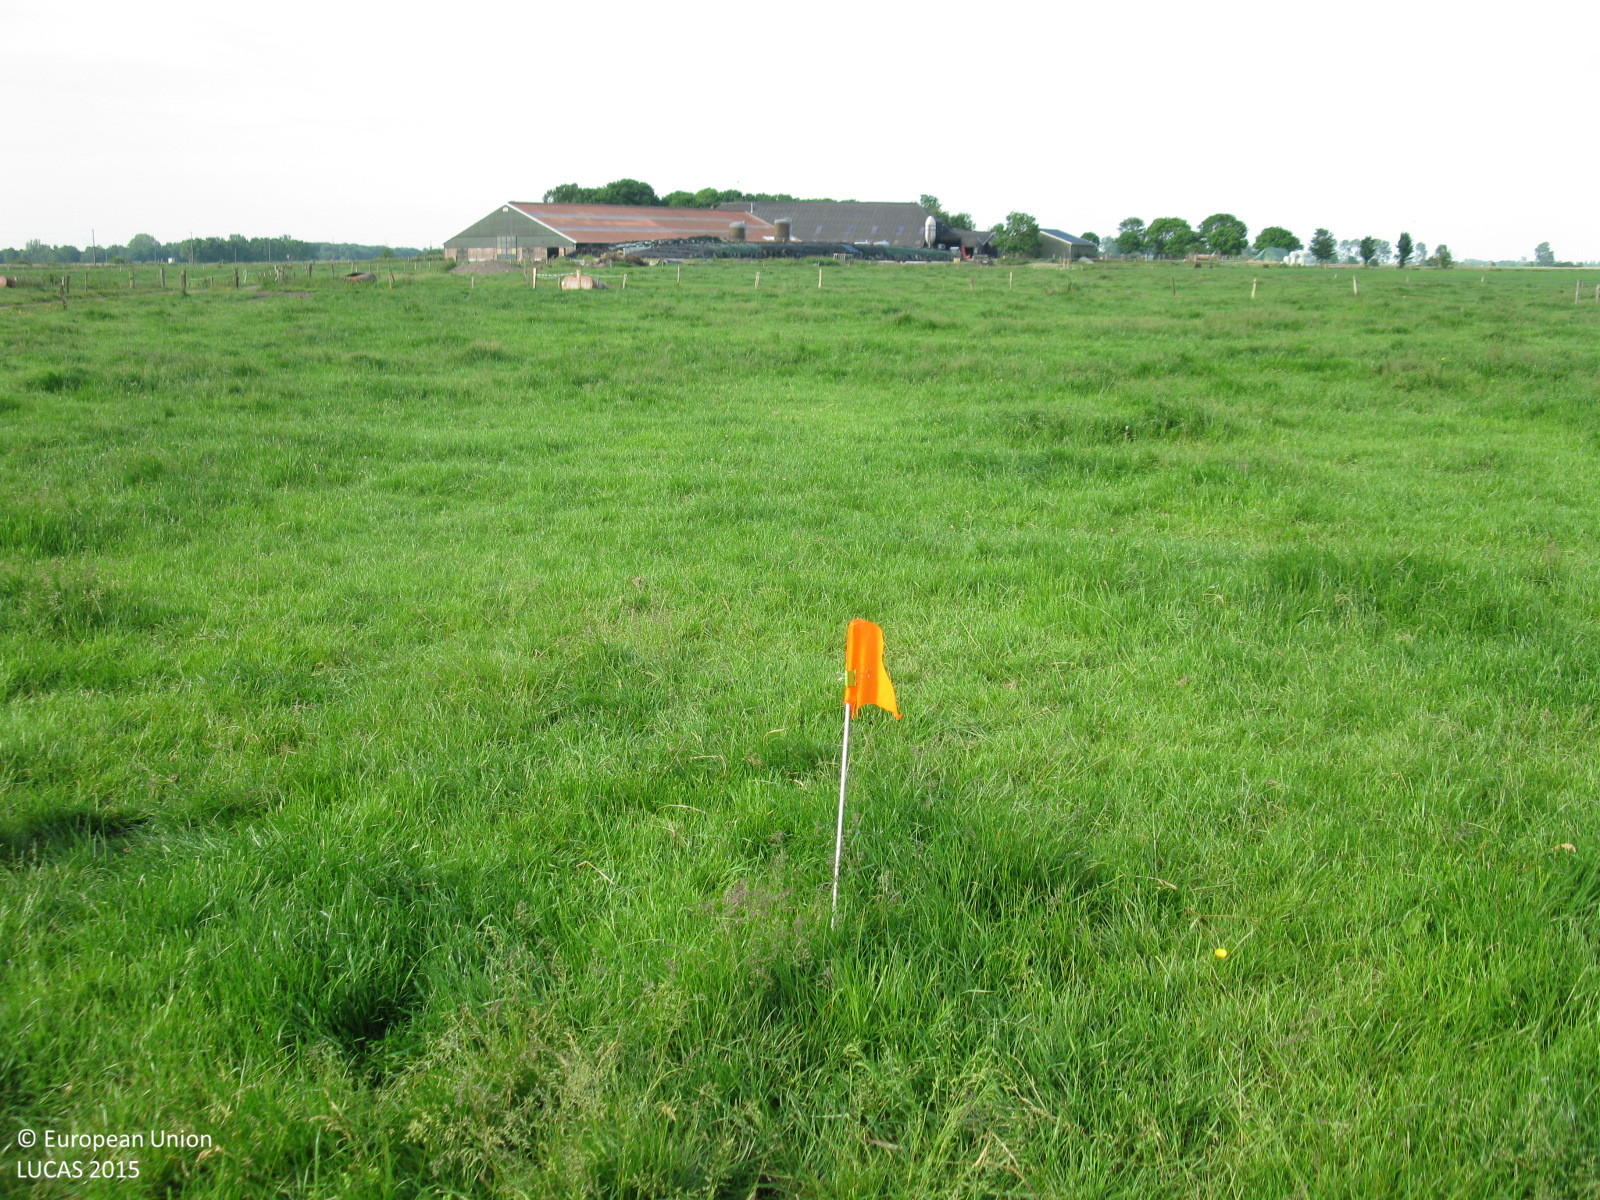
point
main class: Grassland
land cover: Grassland without tree/shrub cover
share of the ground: > 75 %
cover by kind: herbaceous plants 100 %
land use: Agriculture (excluding fallow land and kitchen gardens)
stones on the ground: < 10 %
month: June
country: DE
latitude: 53.4612
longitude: 7.2745
